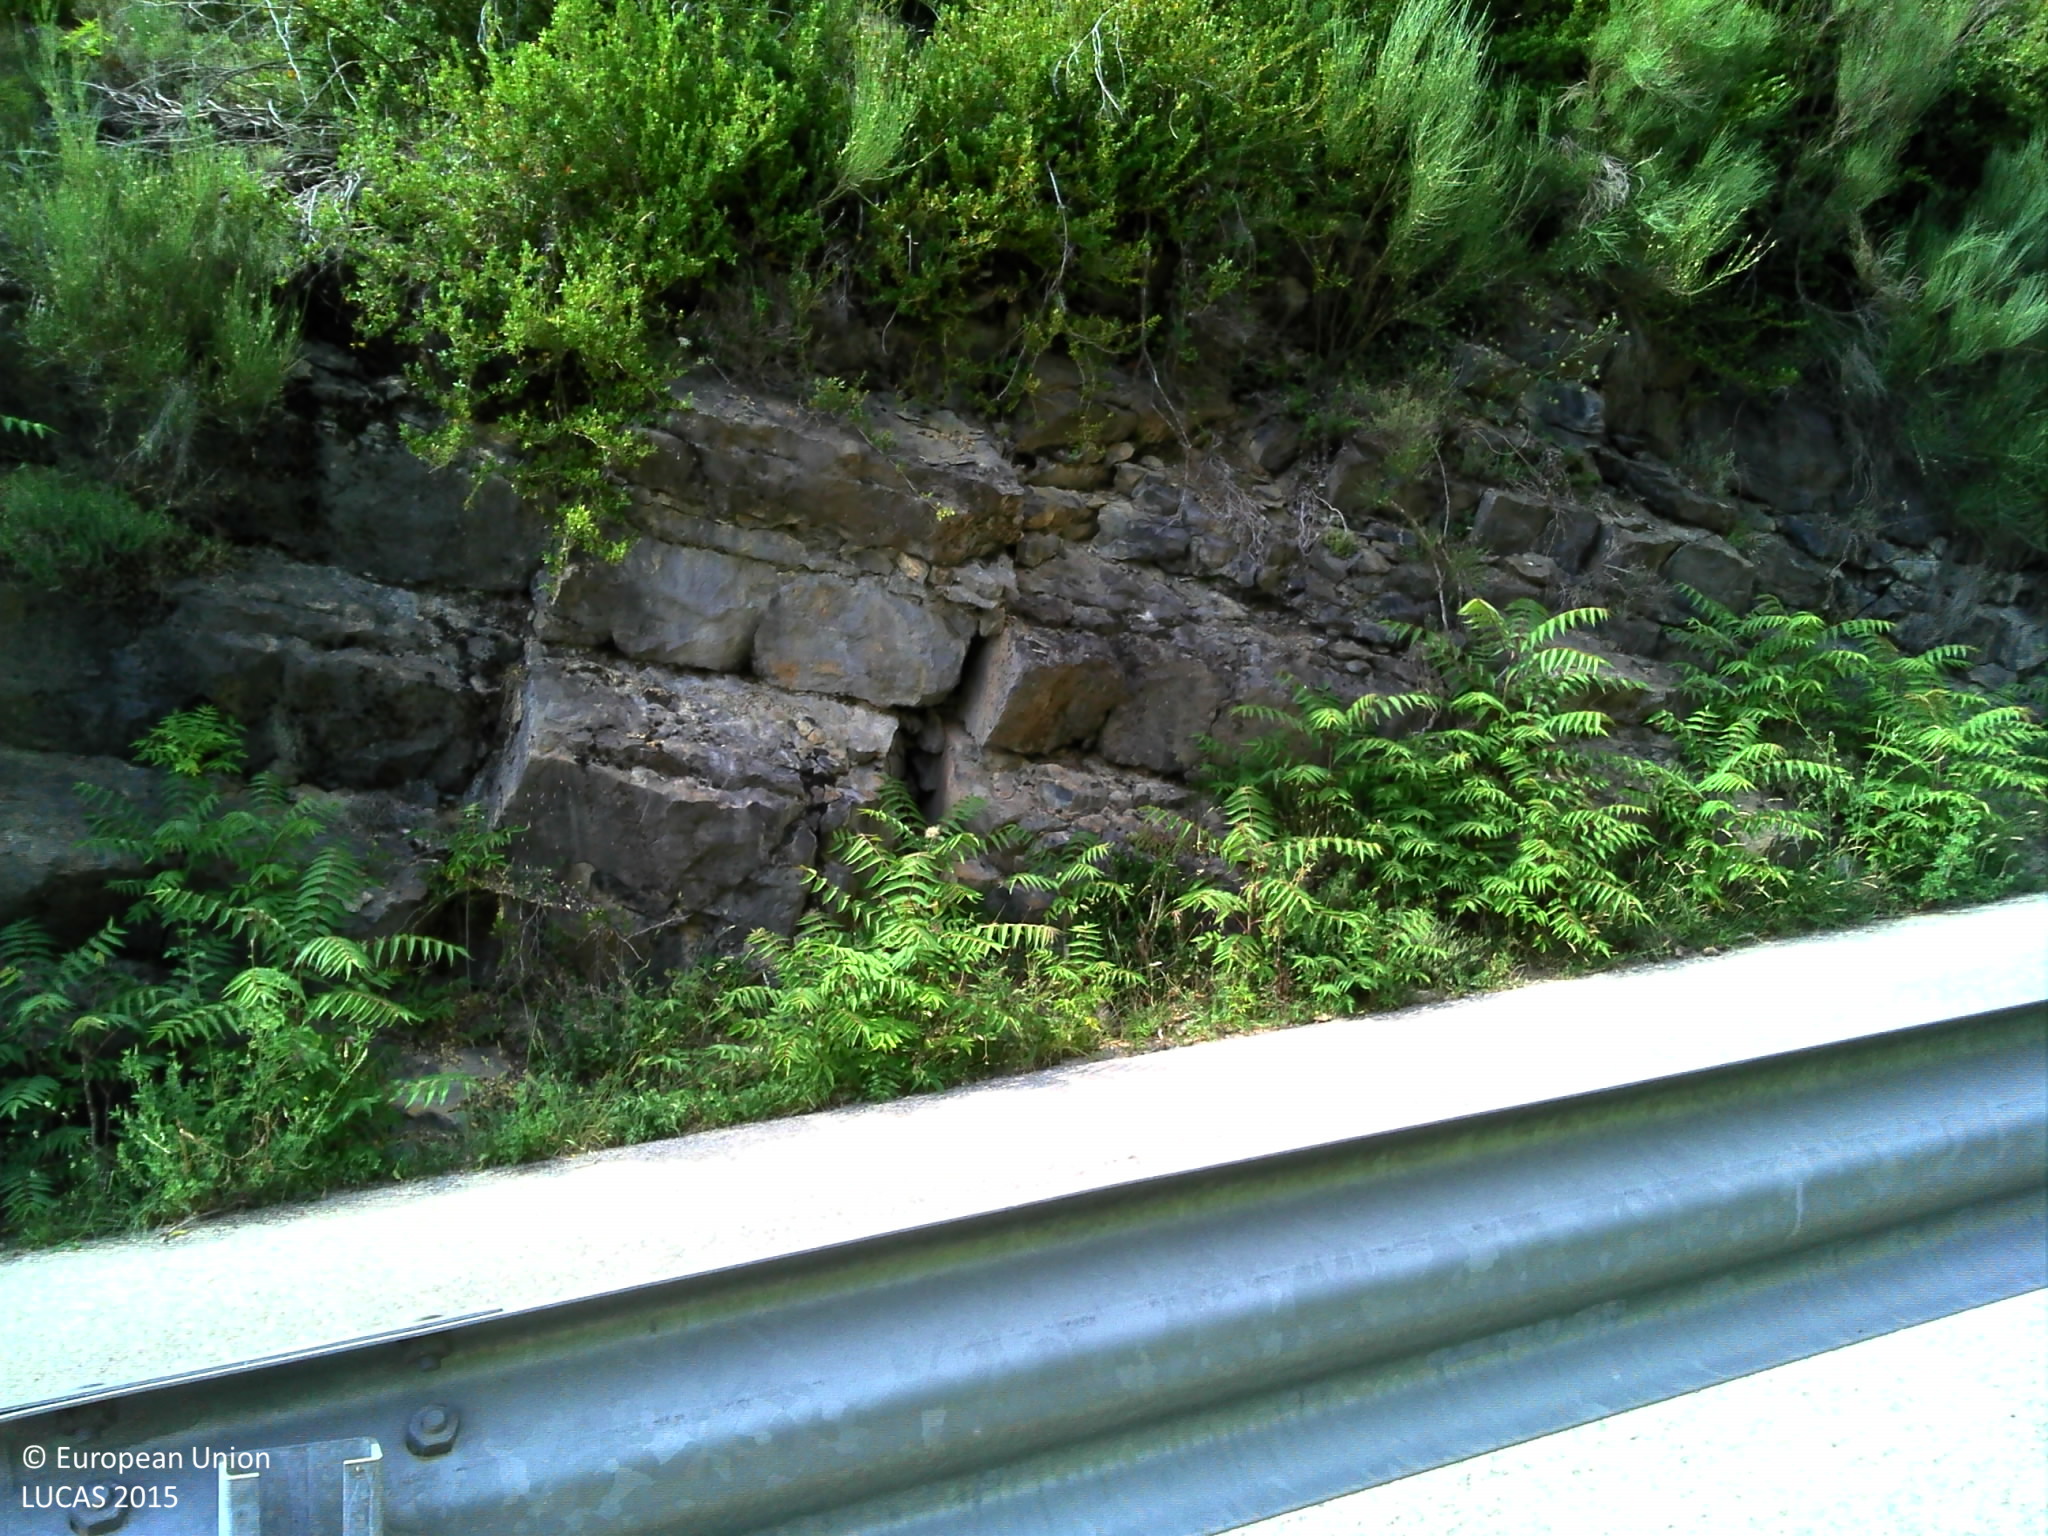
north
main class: Shrubland
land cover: Shrubland with sparse tree cover
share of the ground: > 75 %
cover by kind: shrubs 75 %, herbaceous plants 10 %, unconsolidated bare surface 10 %, broadleaved forest trees 5 %
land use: Semi-natural and natural areas not in use
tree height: < 5 m
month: June
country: FR
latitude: 44.0191
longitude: 7.0251
